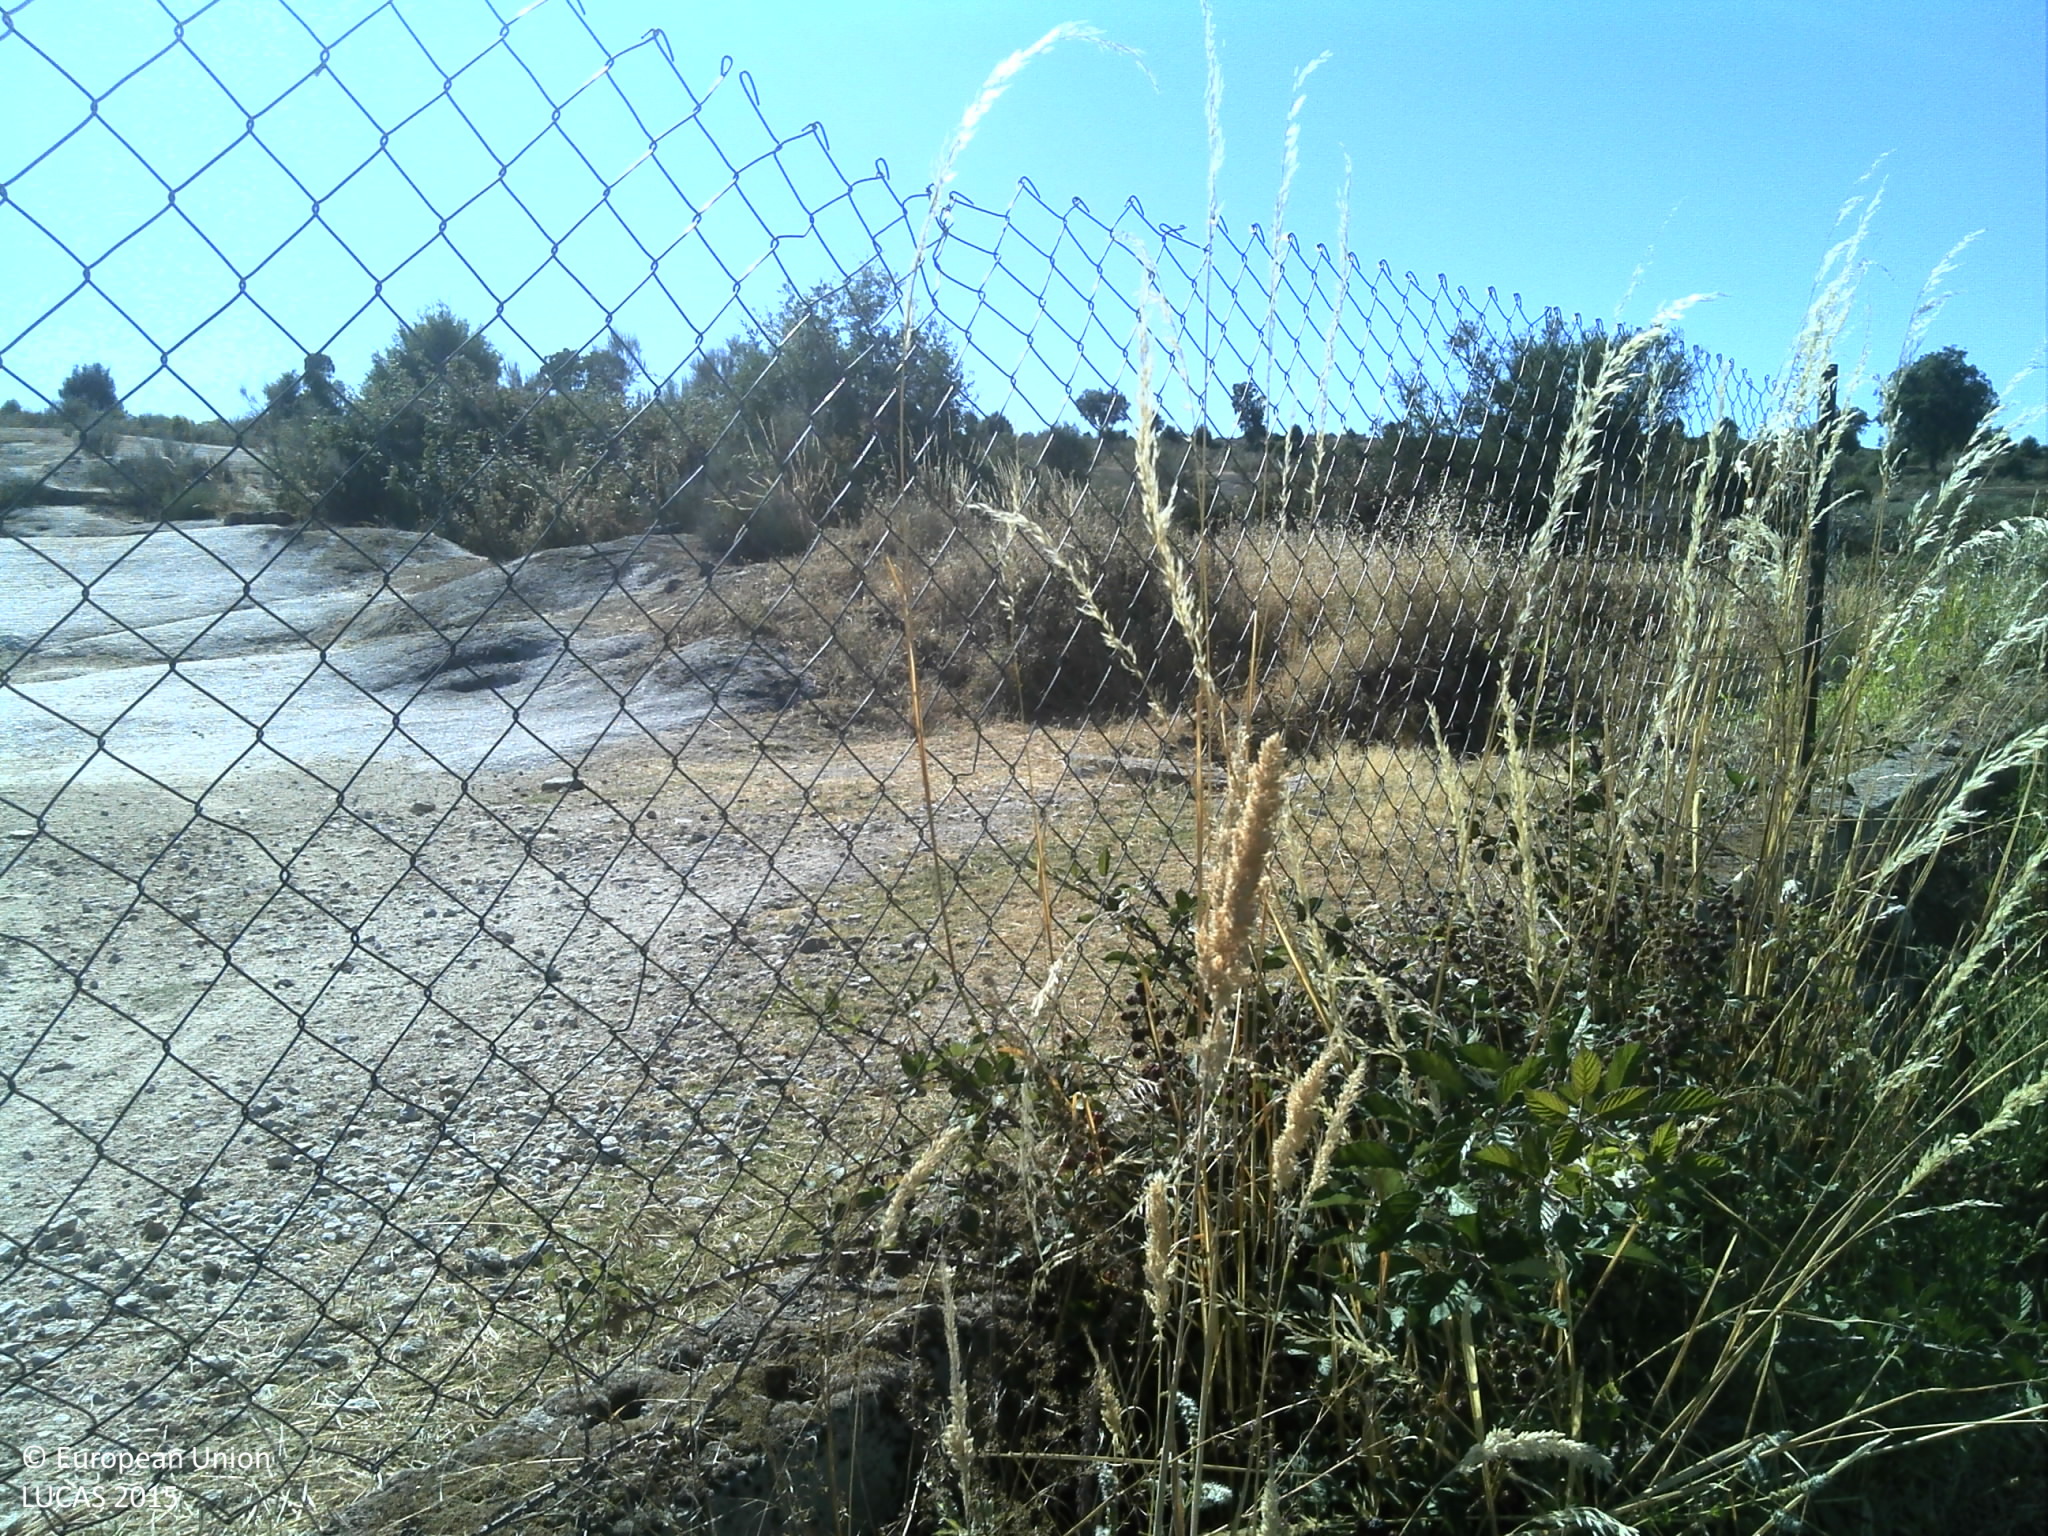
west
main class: Cropland
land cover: Other cereals
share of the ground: > 75 %
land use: Agriculture (excluding fallow land and kitchen gardens)
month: July
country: PT
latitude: 41.2517
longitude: -7.0462
